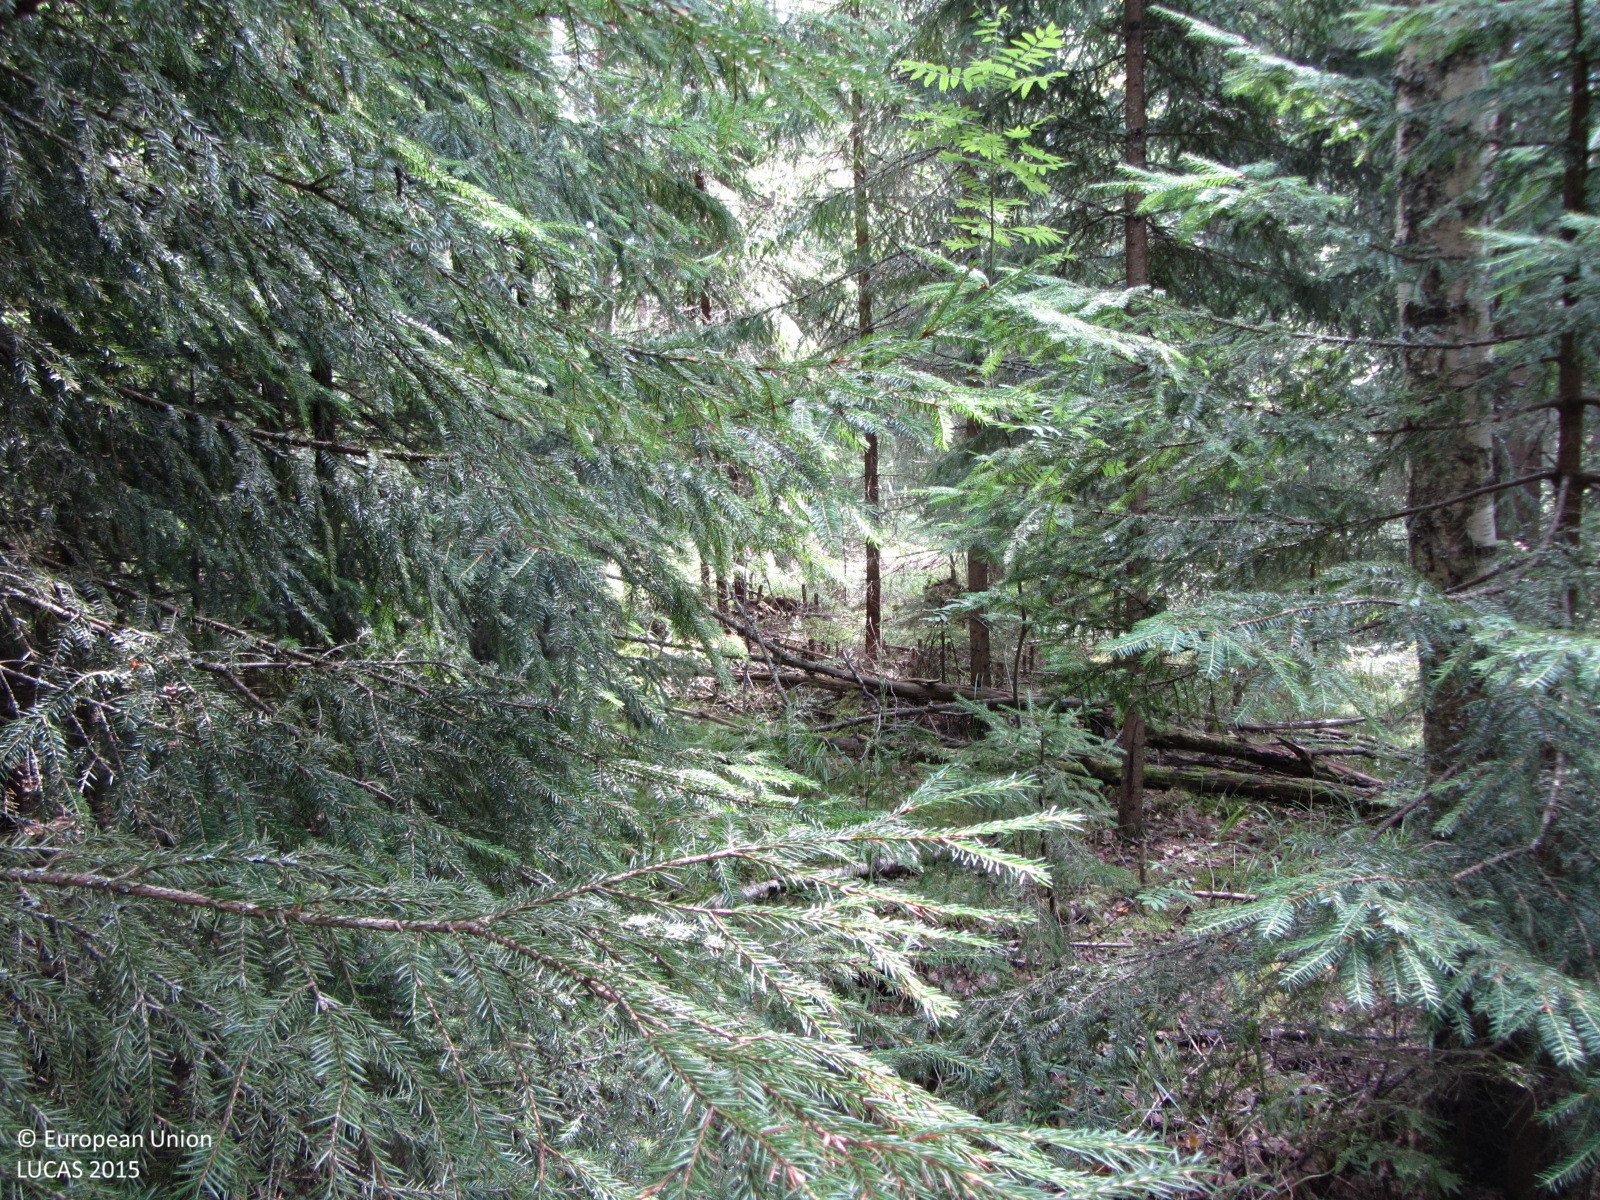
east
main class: Woodland
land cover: Spruce dominated mixed woodland
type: boreal forest
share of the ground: > 75 %
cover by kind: coniferous forest trees 45 %, broadleaved forest trees 45 %, herbaceous plants 10 %
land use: Forestry
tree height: > 5 m
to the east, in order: Spruce dominated mixed woodland; Other mixed woodland; Grassland without tree/shrub cover; Paved roads, cycling and walking lanes; Grassland without tree/shrub cover; Electric lines; Other mixed woodland; Pine dominated coniferous woodland; Peatbogs; Pine dominated coniferous woodland; Peatbogs
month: July
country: FI
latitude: 60.6099
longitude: 24.4069
